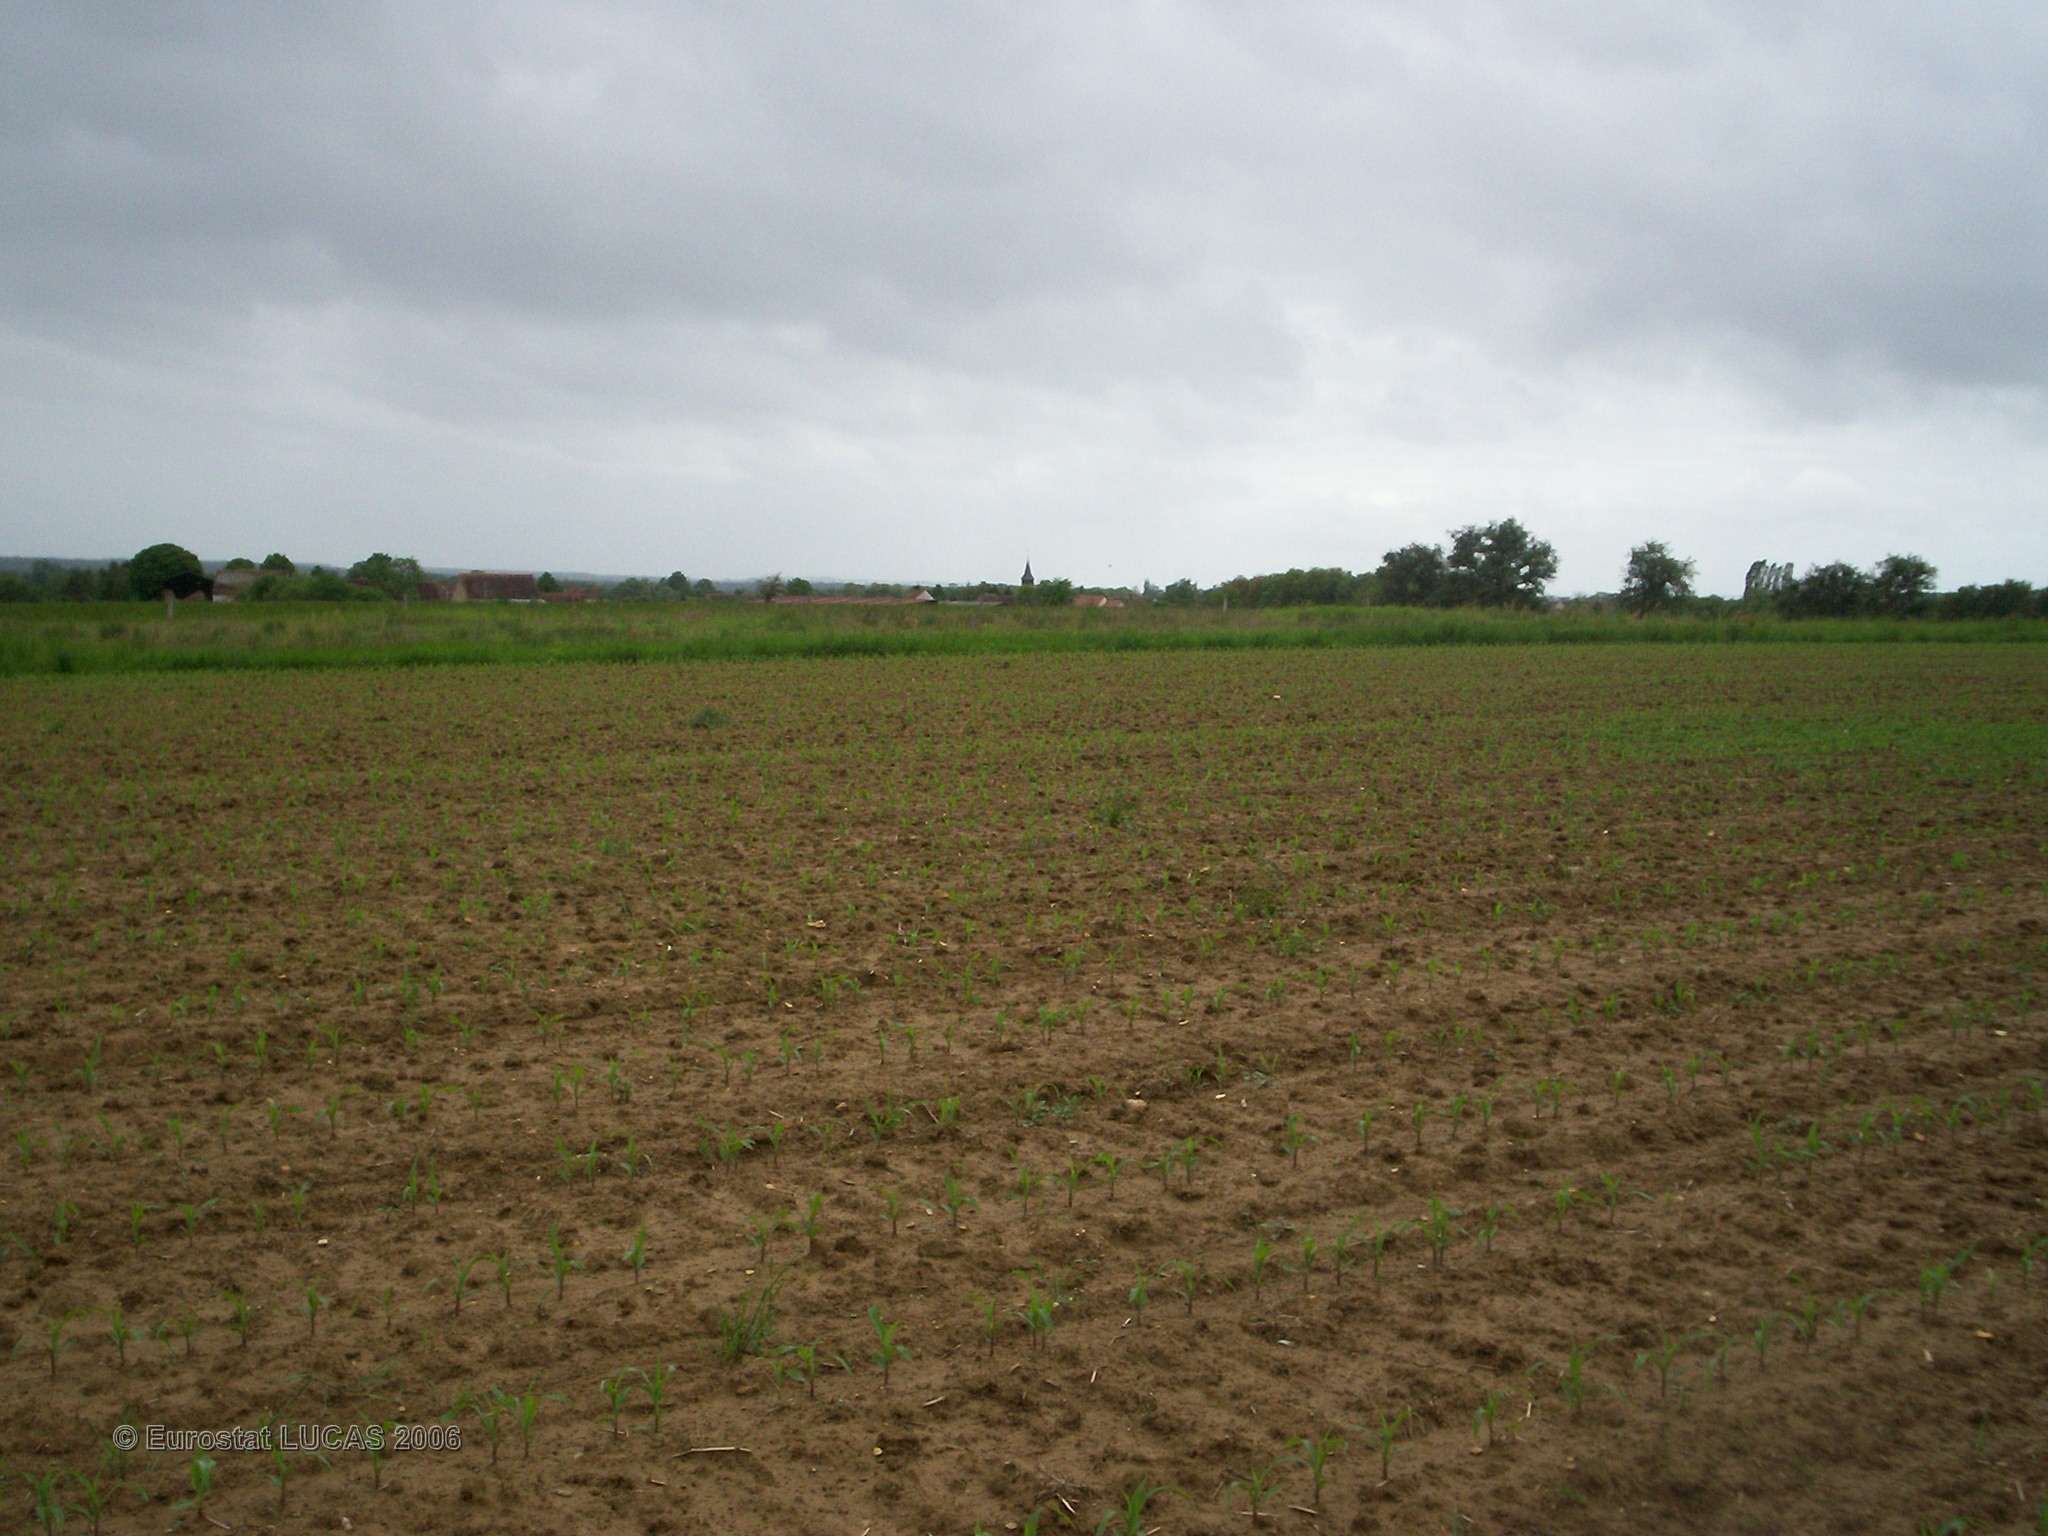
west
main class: Cropland
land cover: Maize
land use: Agriculture (excluding fallow land and kitchen gardens)
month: May
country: FR
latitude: 47.9780
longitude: 3.8202
